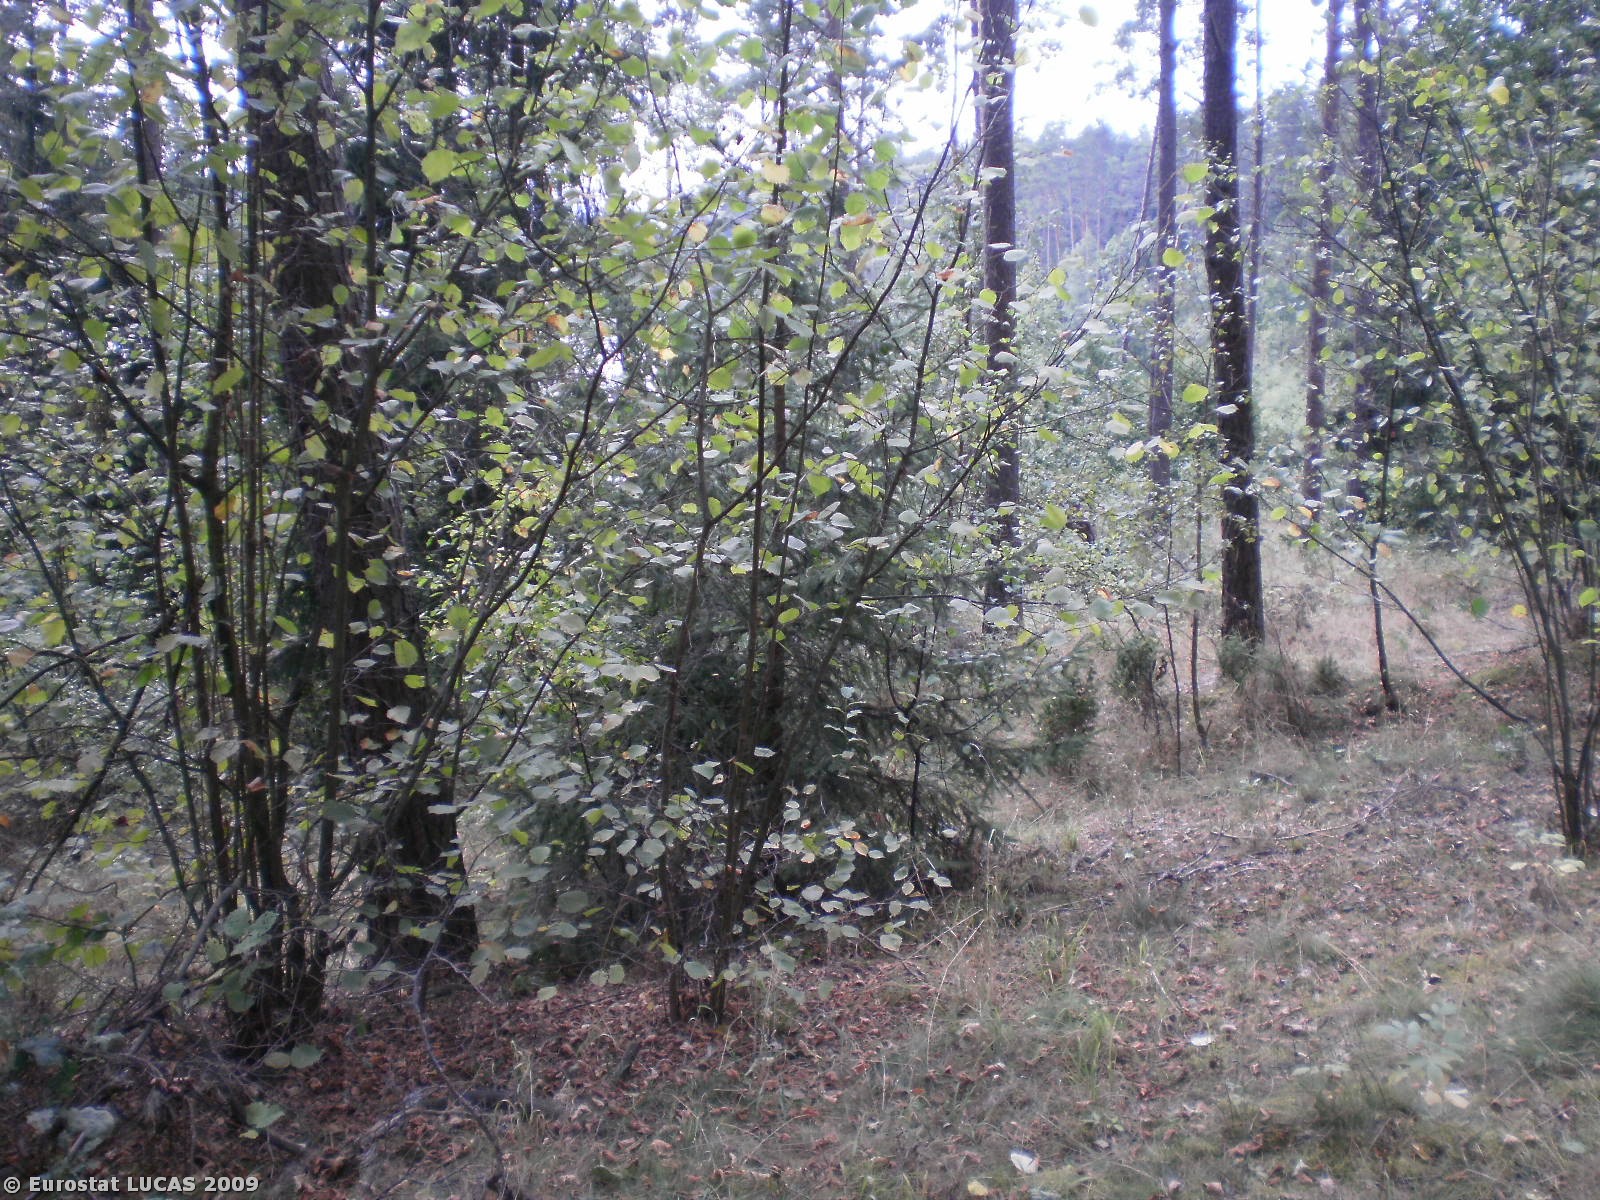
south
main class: Woodland
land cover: Coniferous woodland
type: hemiboreal forest and nemoral coniferous forest and mixed broadleaved-coniferous forest
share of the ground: 50 - 75 %
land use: Forestry
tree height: > 5 m
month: September
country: PL
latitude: 53.7156
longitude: 21.3976
